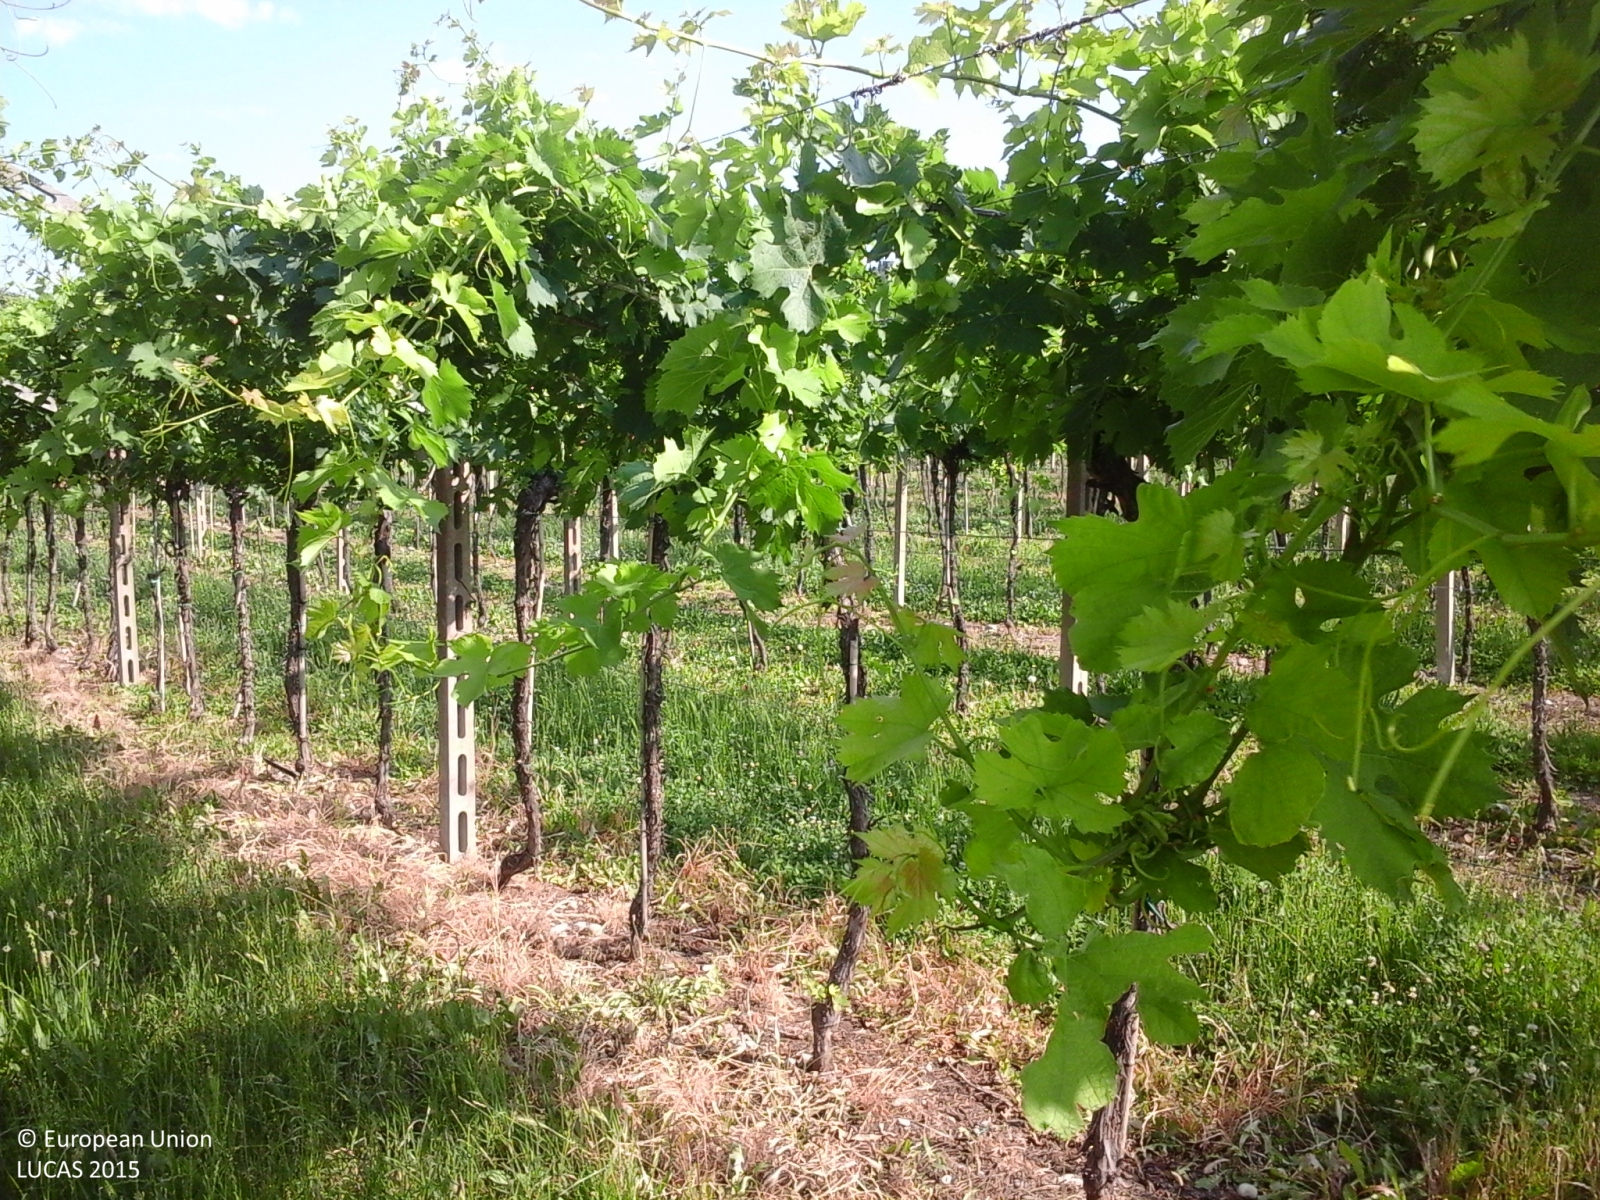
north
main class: Cropland
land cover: Vineyards
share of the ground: > 75 %
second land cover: Grassland without tree/shrub cover
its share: > 75 %
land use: Agriculture (excluding fallow land and kitchen gardens)
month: June
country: IT
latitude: 45.5378
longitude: 10.7543
